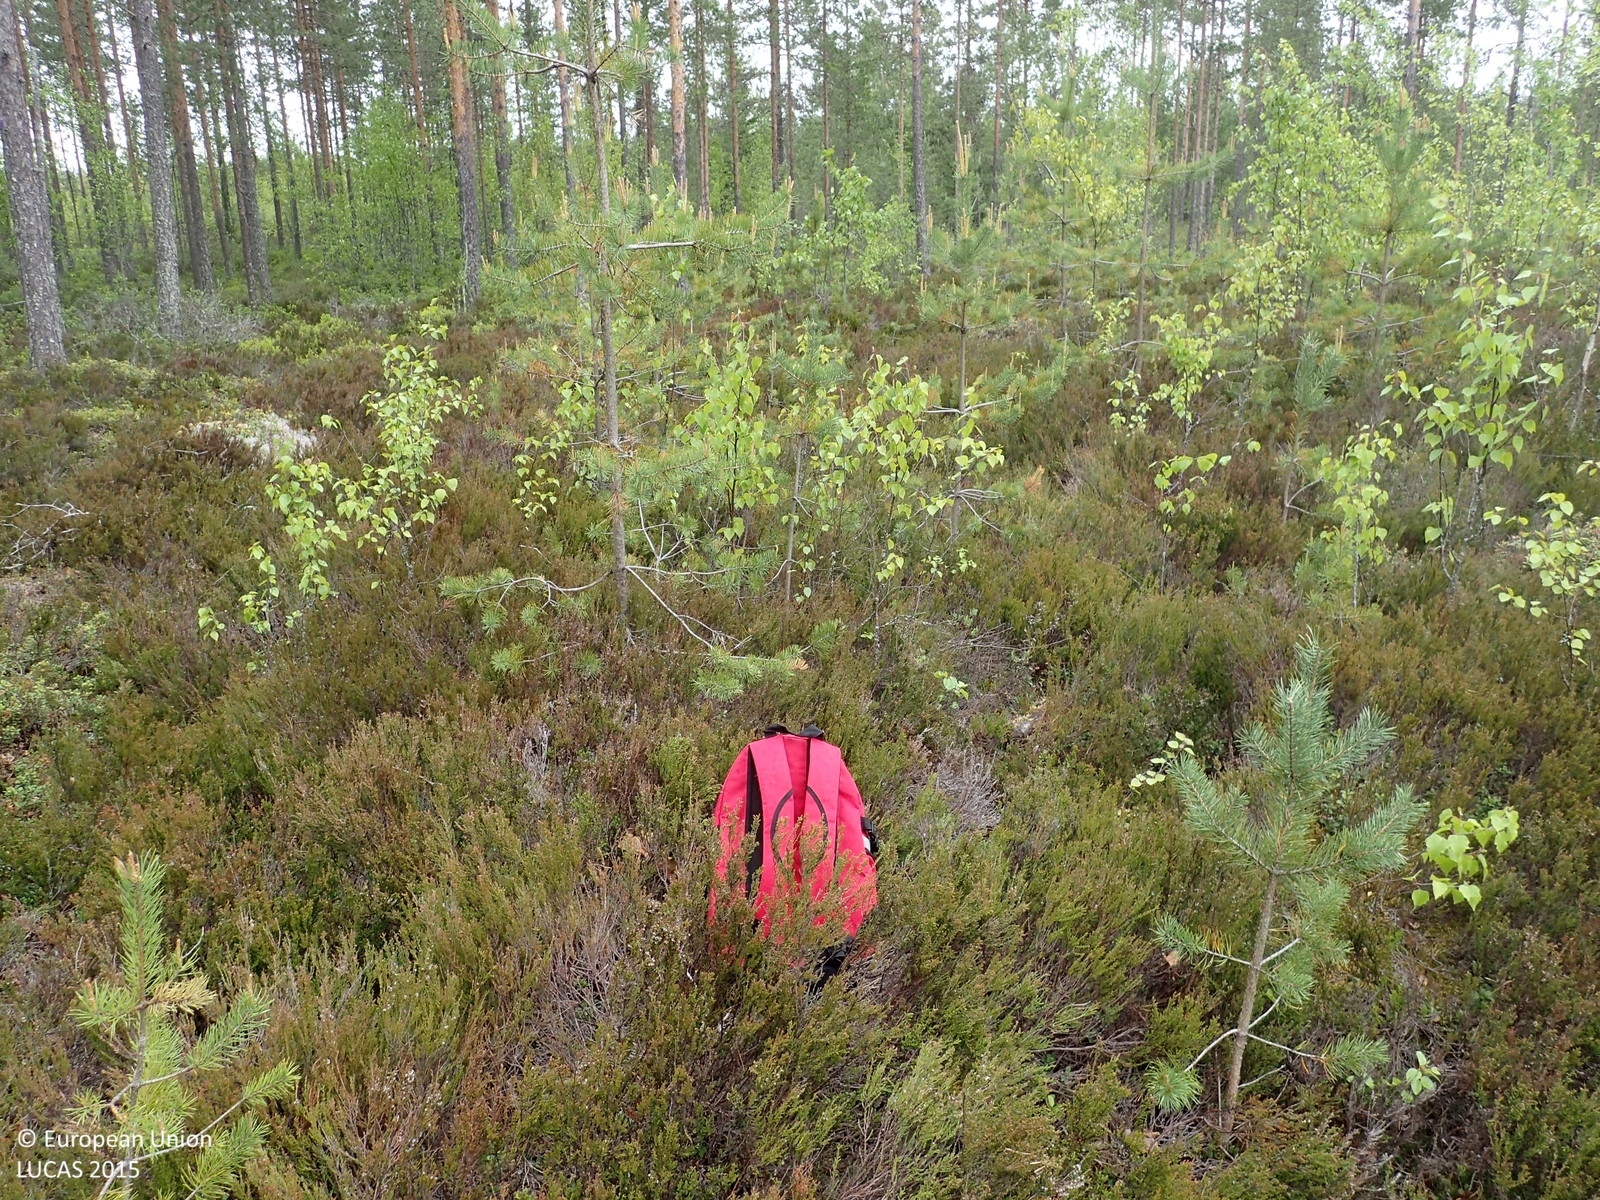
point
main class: Woodland
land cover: Broadleaved woodland
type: boreal forest
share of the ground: 25 - 50 %
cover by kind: shrubs 70 %, broadleaved forest trees 25 %, coniferous forest trees 5 %
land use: Forestry
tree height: < 5 m
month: June
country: FI
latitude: 62.4775
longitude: 22.4505
